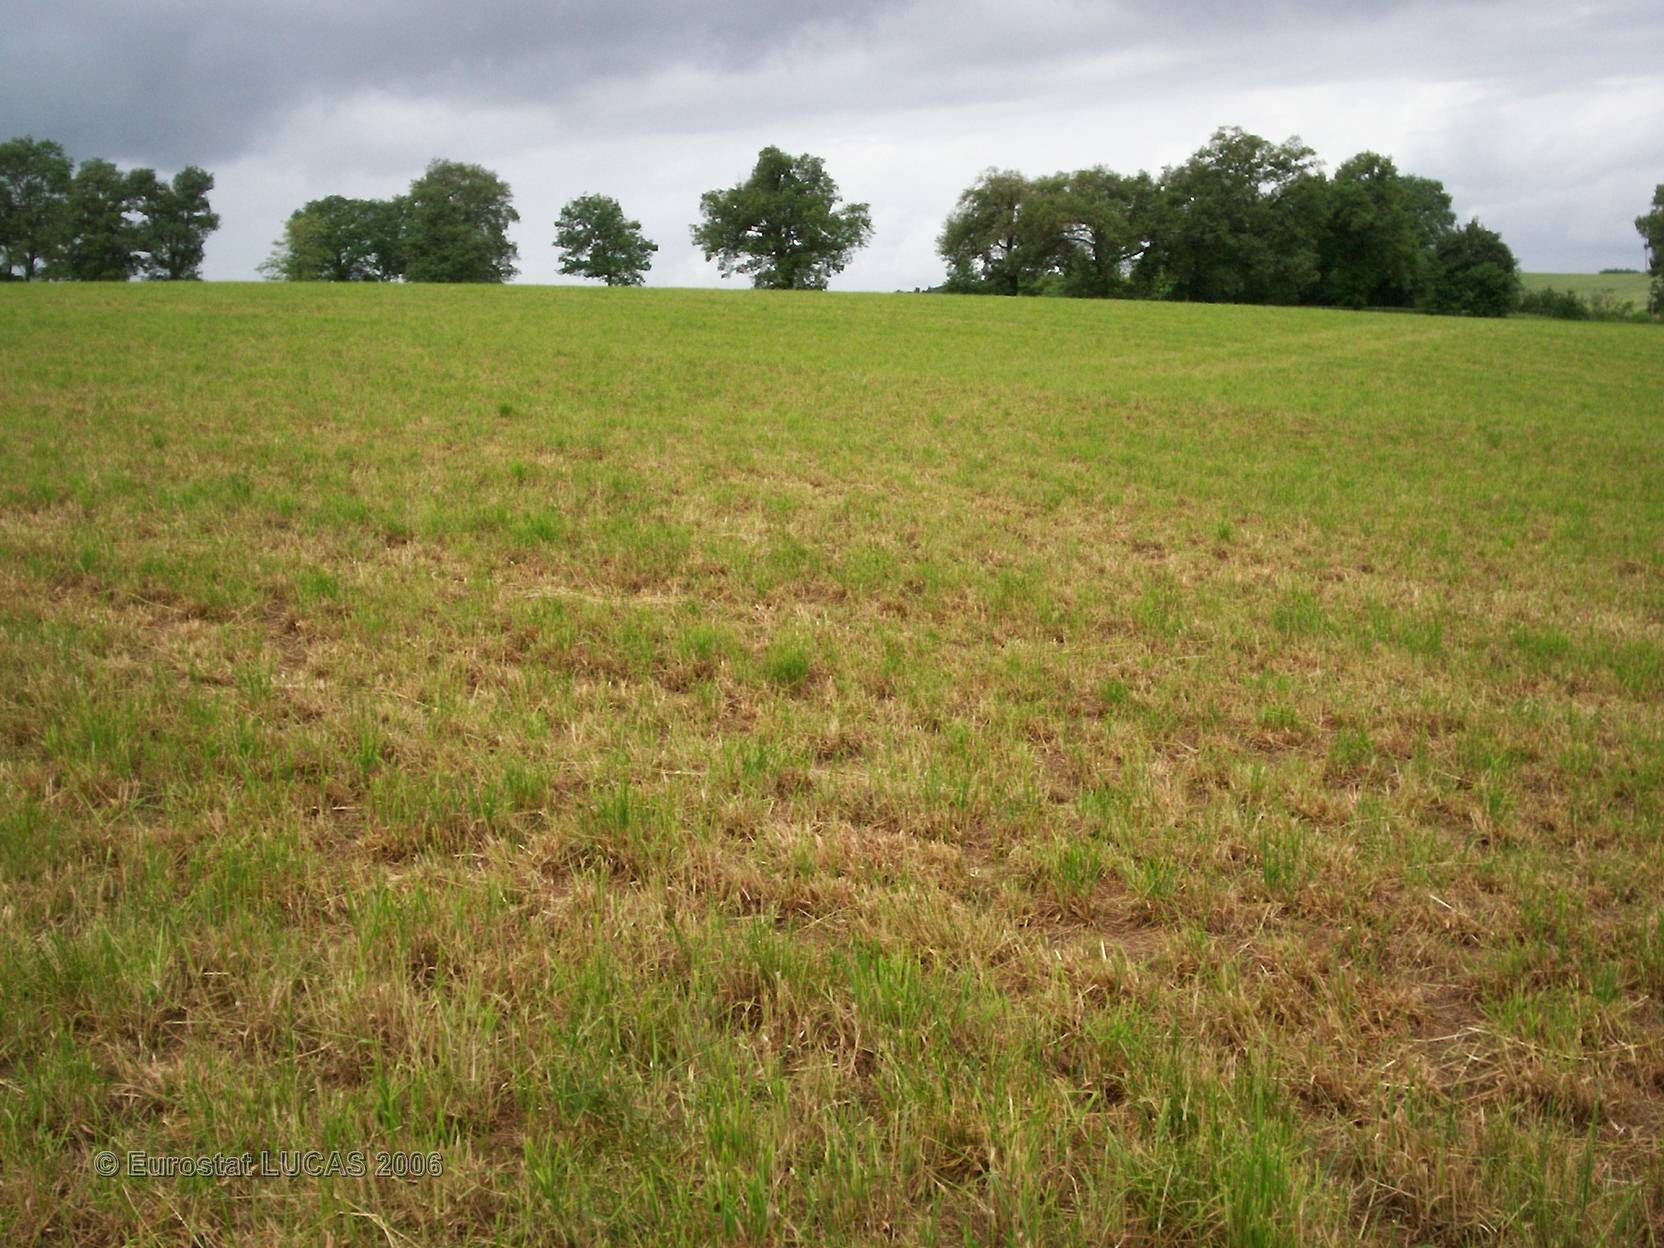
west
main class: Grassland
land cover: Grassland without tree/shrub cover
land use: Agriculture (excluding fallow land and kitchen gardens)
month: May
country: FR
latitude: 43.6134
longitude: 0.9922
